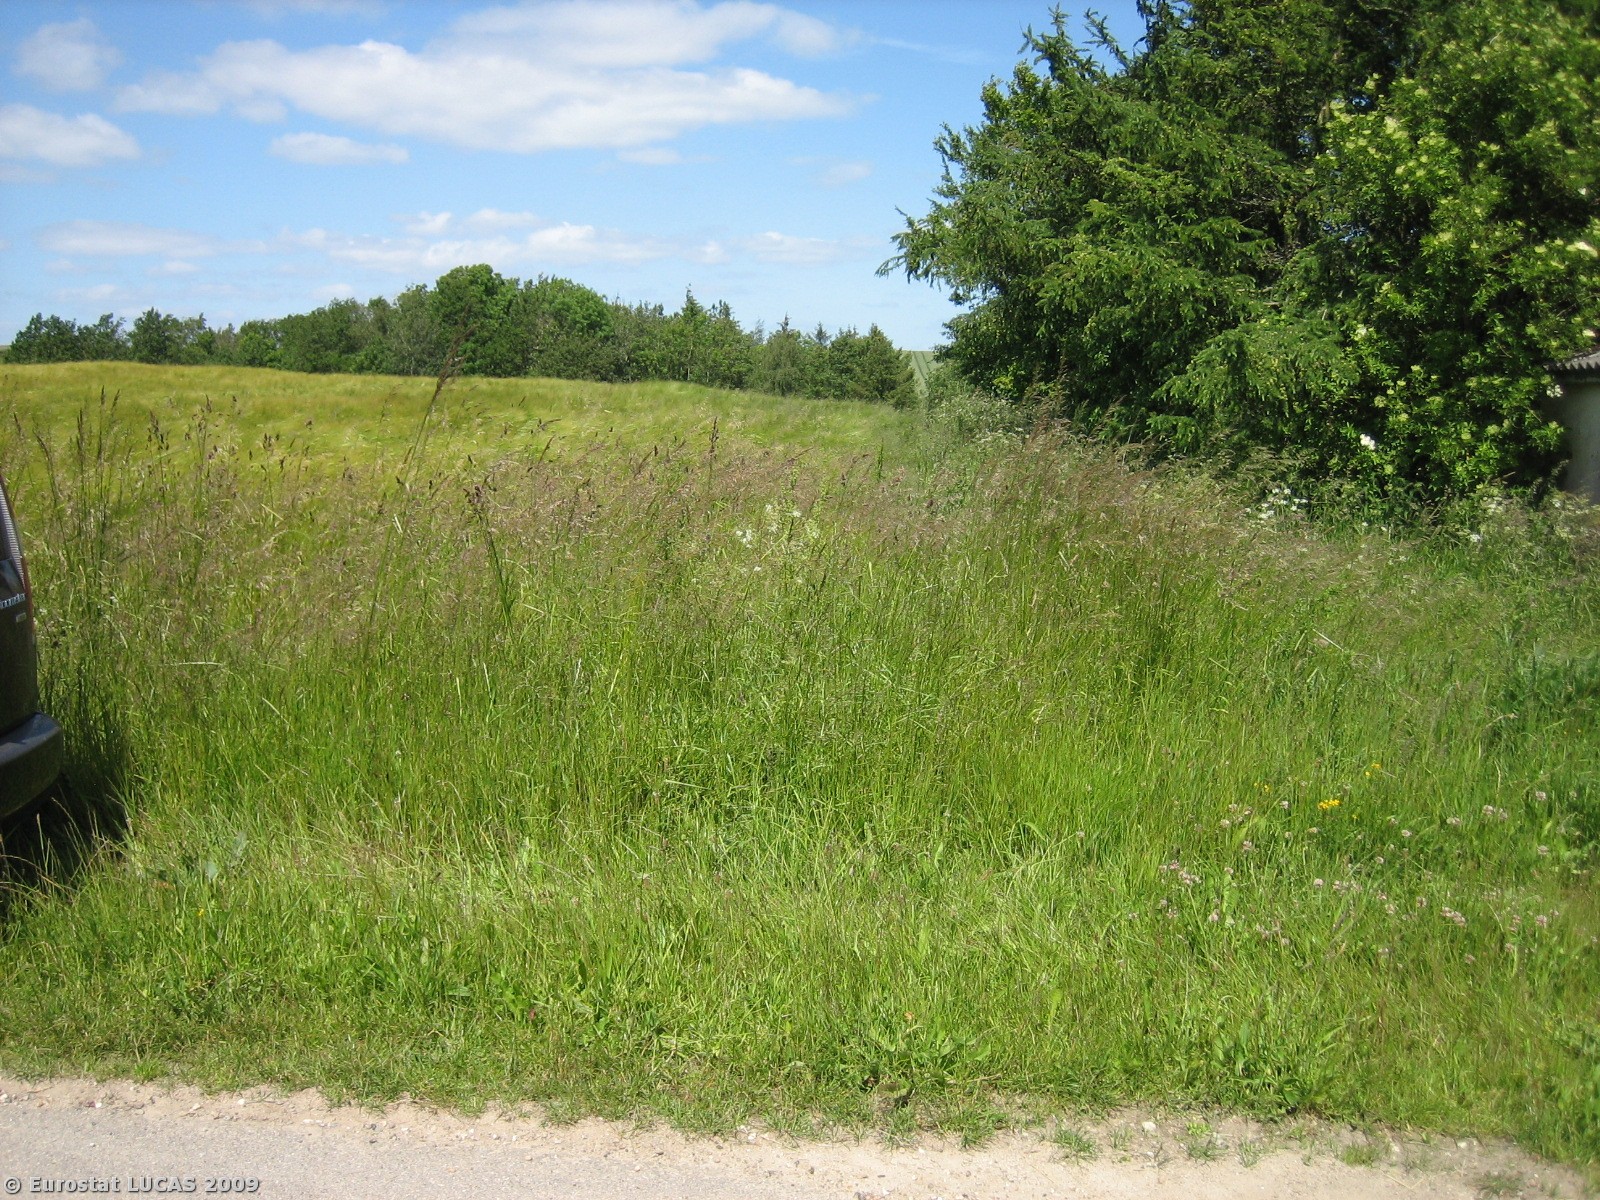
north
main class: Cropland
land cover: Common wheat
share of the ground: > 75 %
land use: Agriculture (excluding fallow land and kitchen gardens)
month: June
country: DK
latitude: 55.7024
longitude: 9.8887
